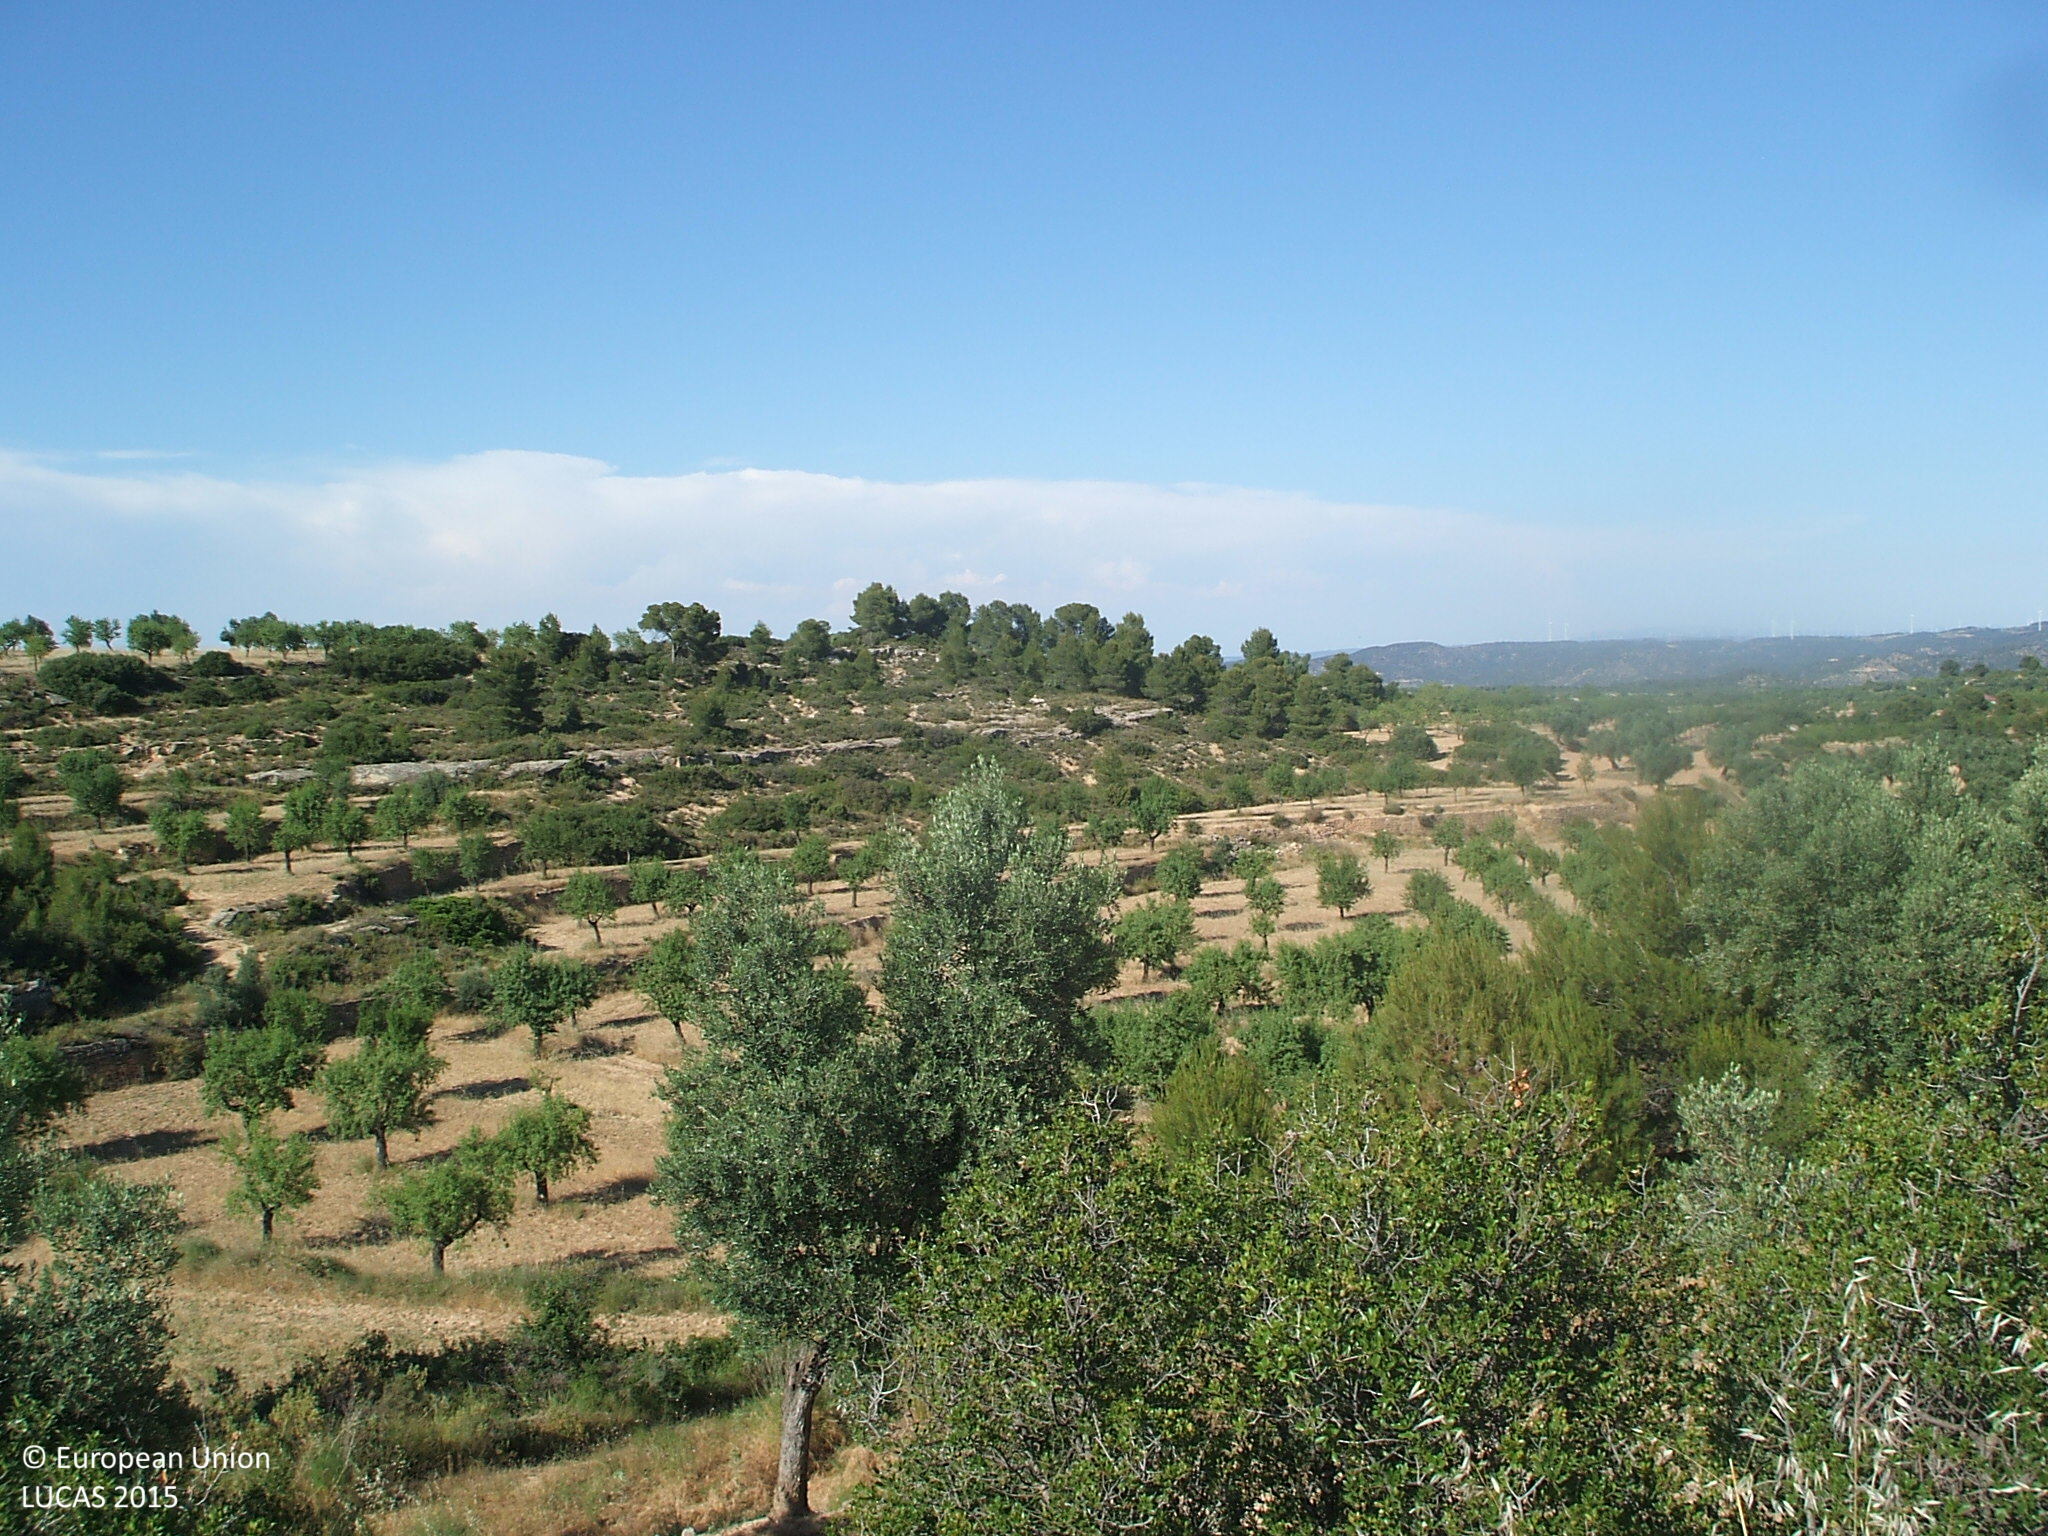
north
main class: Shrubland
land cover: Shrubland without tree cover
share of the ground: > 75 %
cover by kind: shrubs 100 %
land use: Agriculture (excluding fallow land and kitchen gardens)
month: June
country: ES
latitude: 41.0296
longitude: 0.1780
